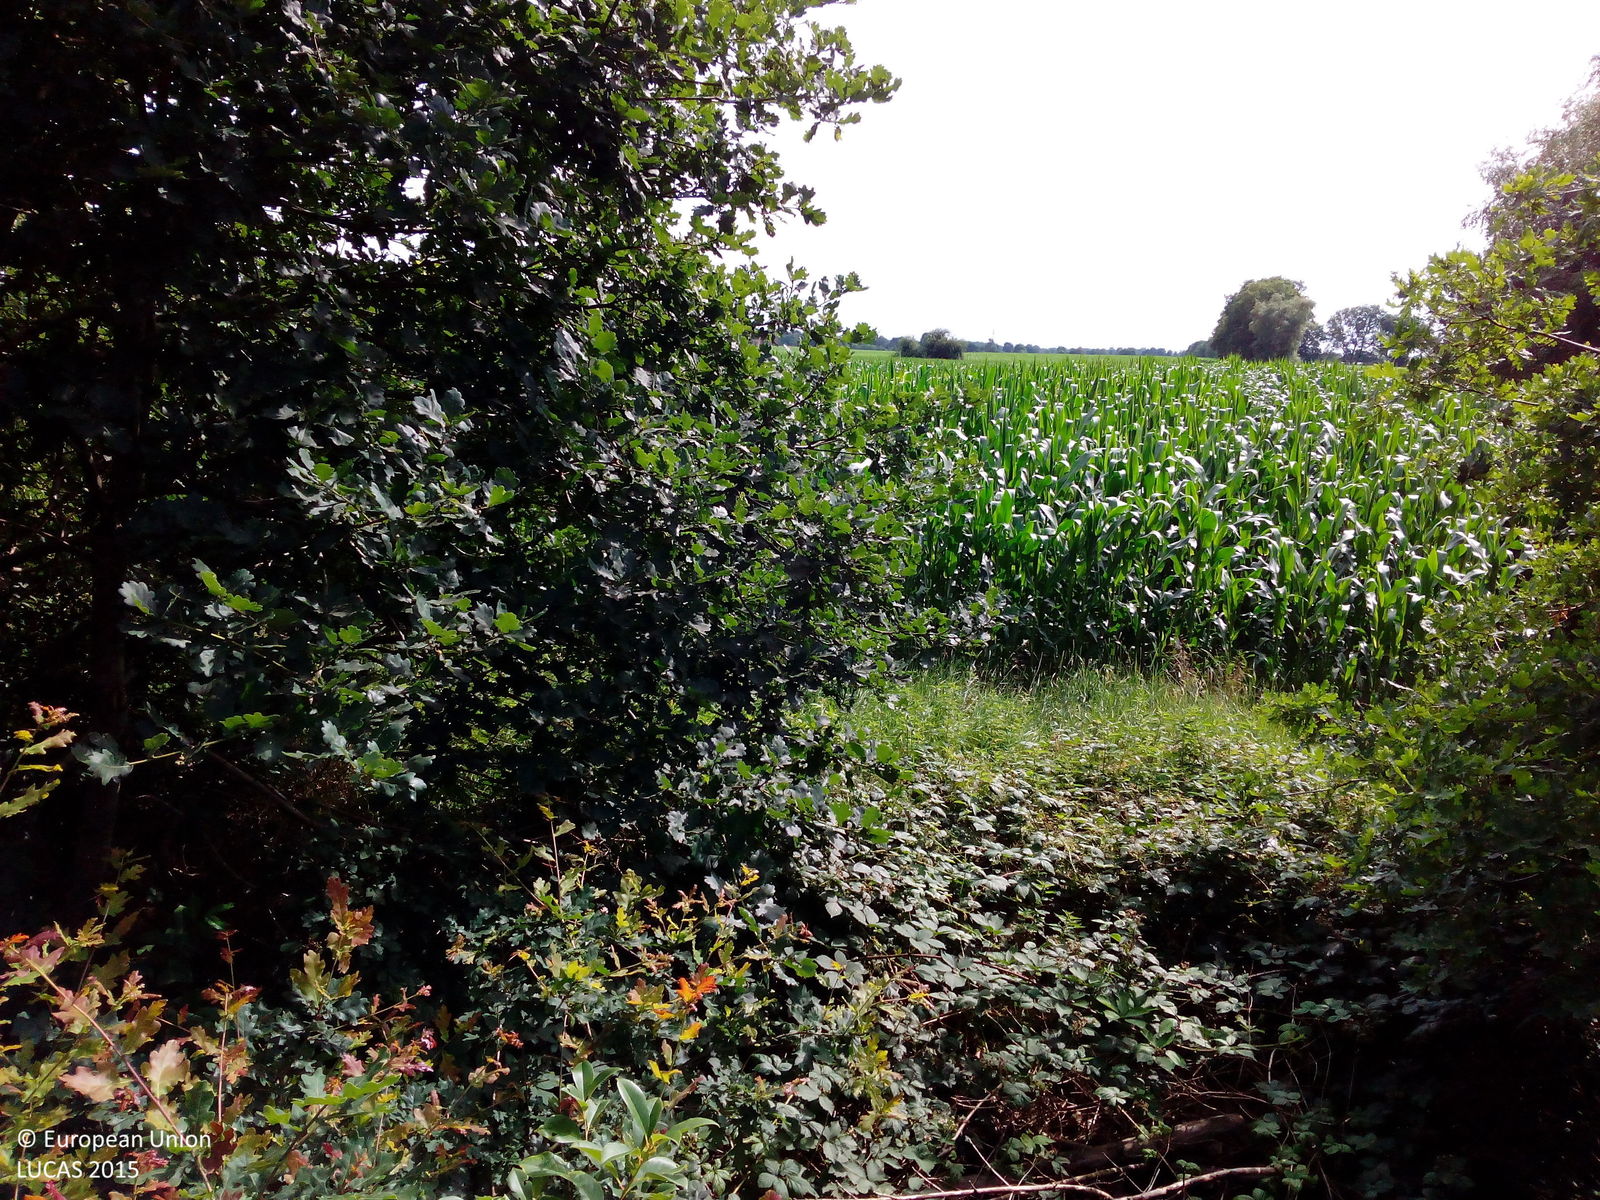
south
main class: Cropland
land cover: Maize
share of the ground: > 75 %
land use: Agriculture (excluding fallow land and kitchen gardens)
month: July
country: DE
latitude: 53.0067
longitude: 7.9291
